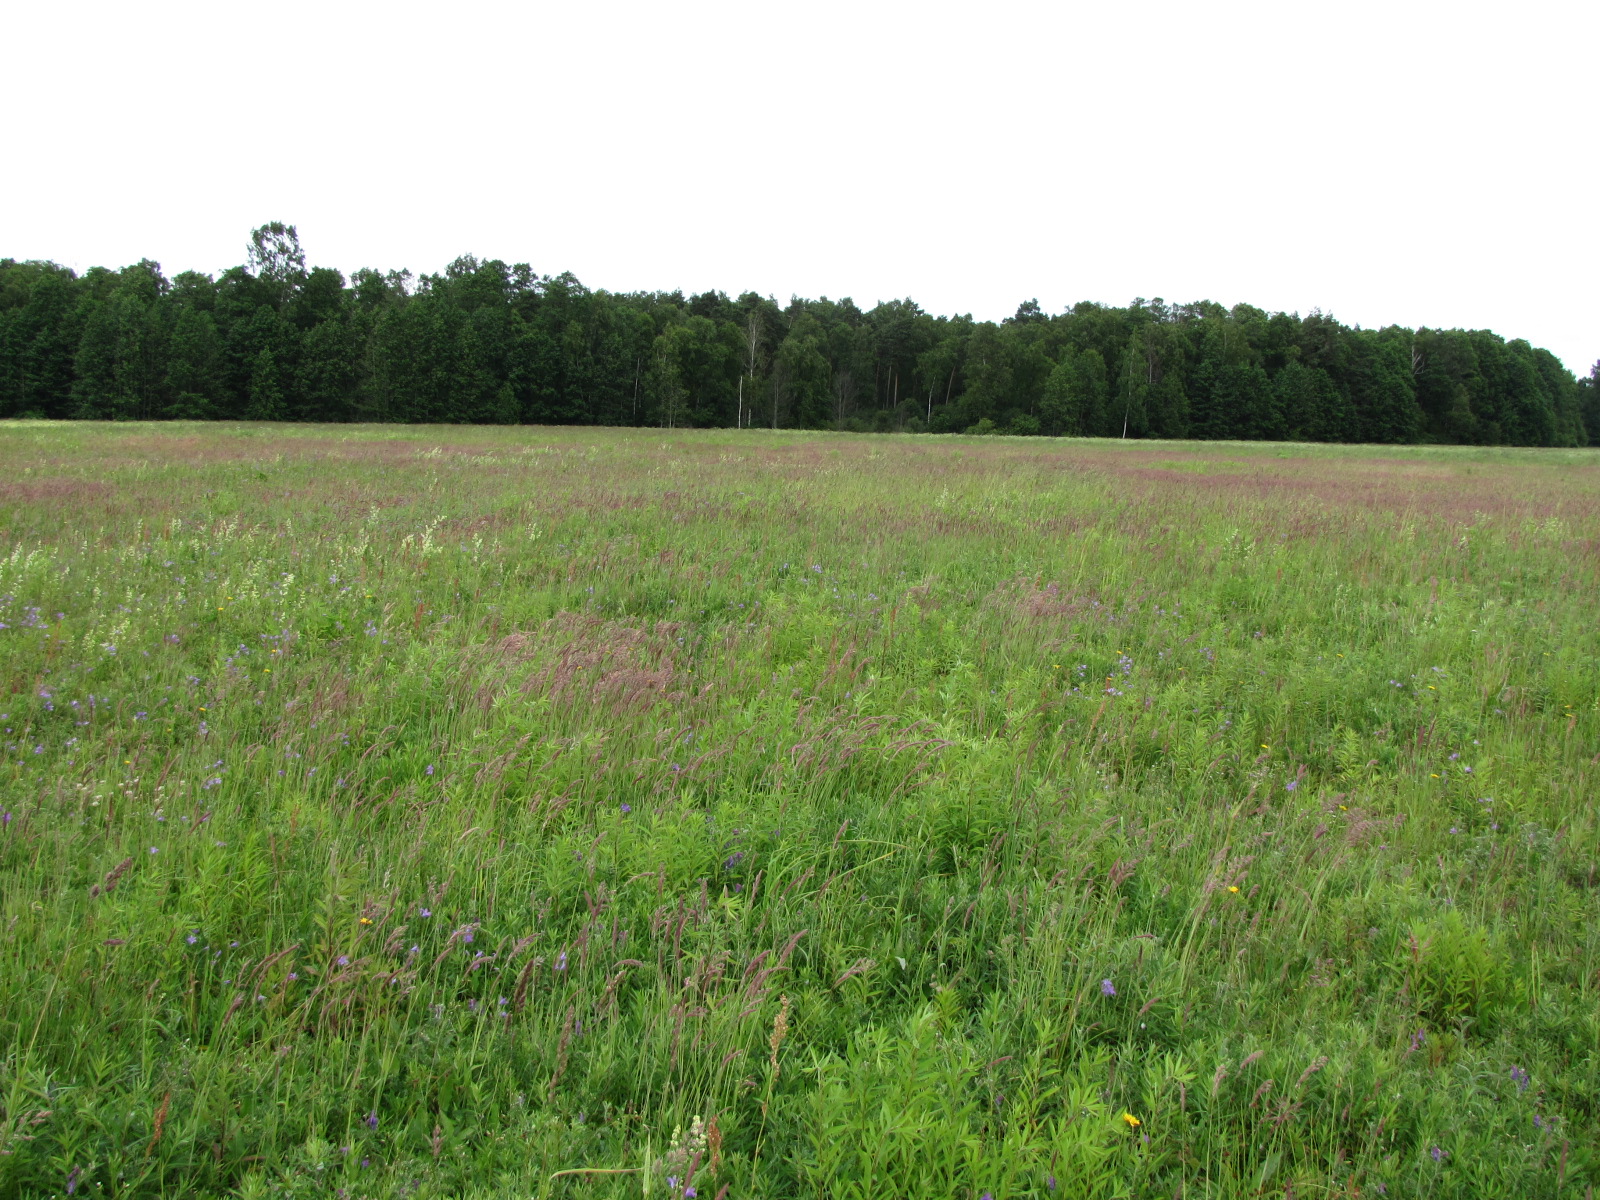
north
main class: Grassland
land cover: Grassland without tree/shrub cover
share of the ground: > 75 %
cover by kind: herbaceous plants 100 %
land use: Agriculture (excluding fallow land and kitchen gardens)
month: June
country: LV
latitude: 56.9605
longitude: 23.9117
